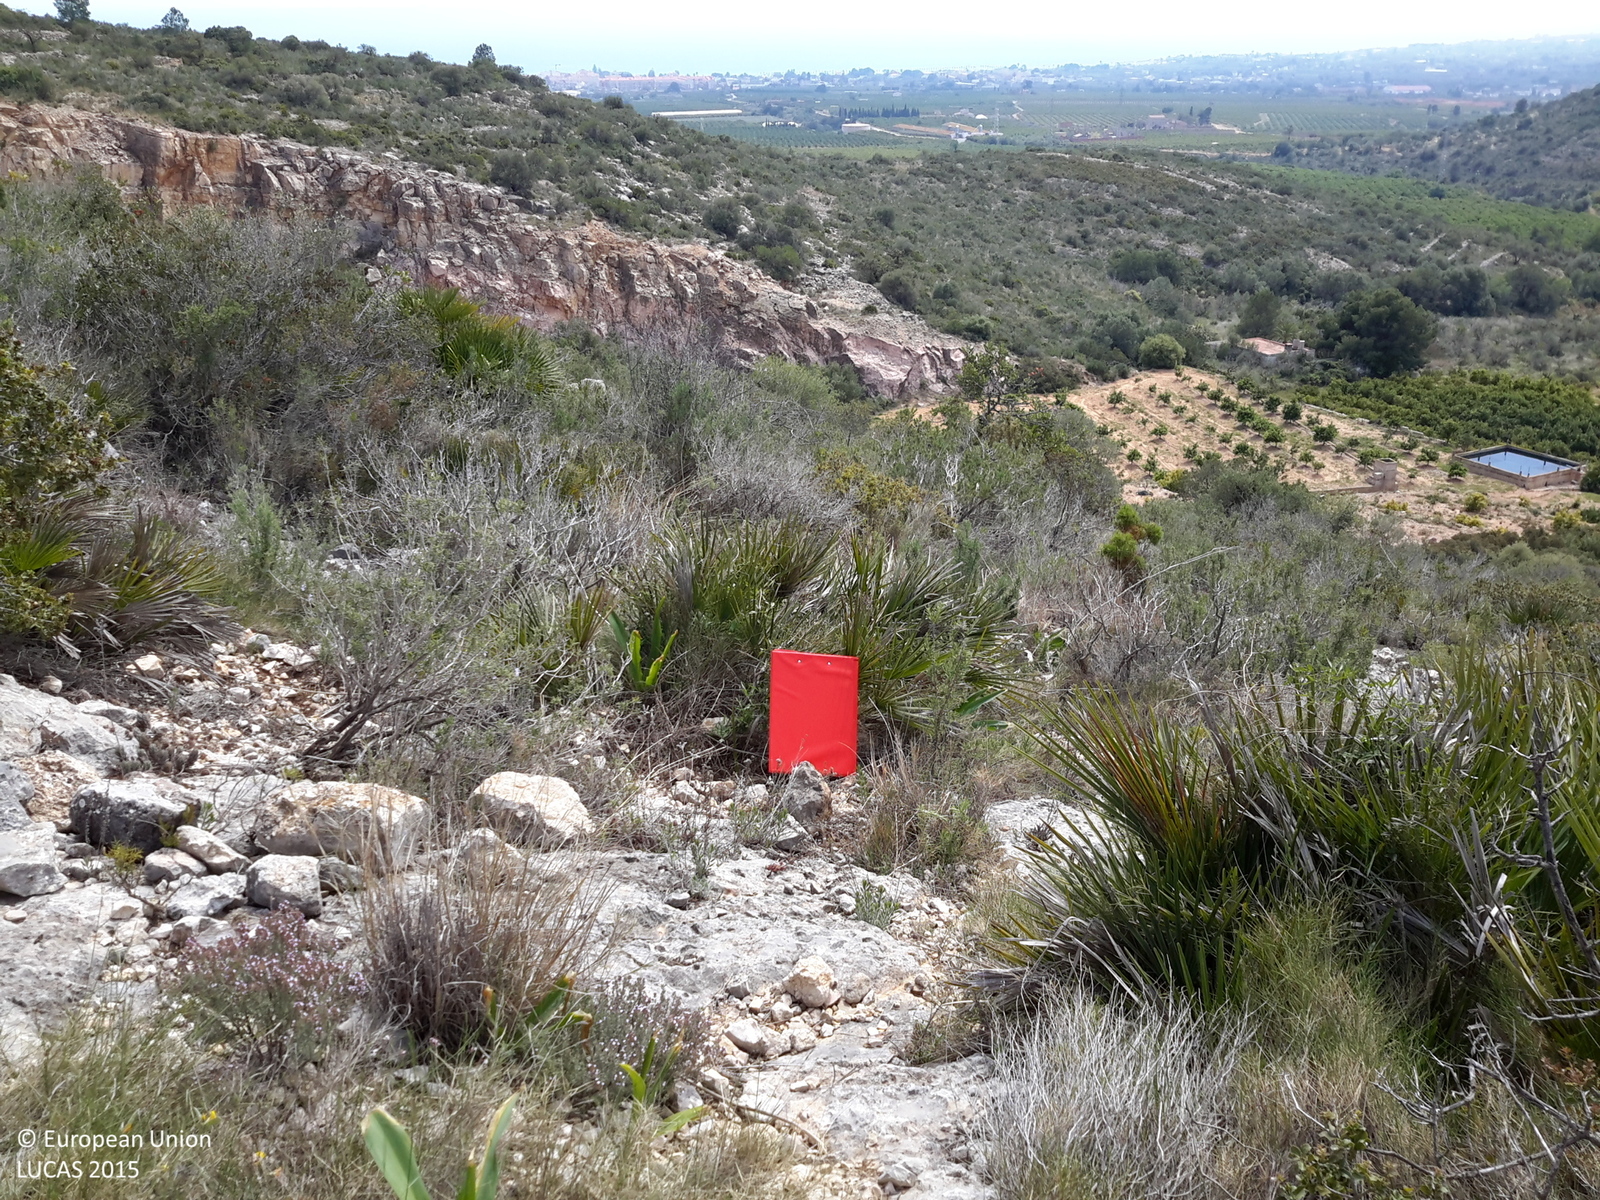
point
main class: Shrubland
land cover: Shrubland with sparse tree cover
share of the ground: > 75 %
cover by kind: shrubs 70 %, unconsolidated bare surface 25 %, coniferous forest trees 5 %
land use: Semi-natural and natural areas not in use
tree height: < 5 m
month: April
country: ES
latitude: 40.5709
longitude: 0.5107
